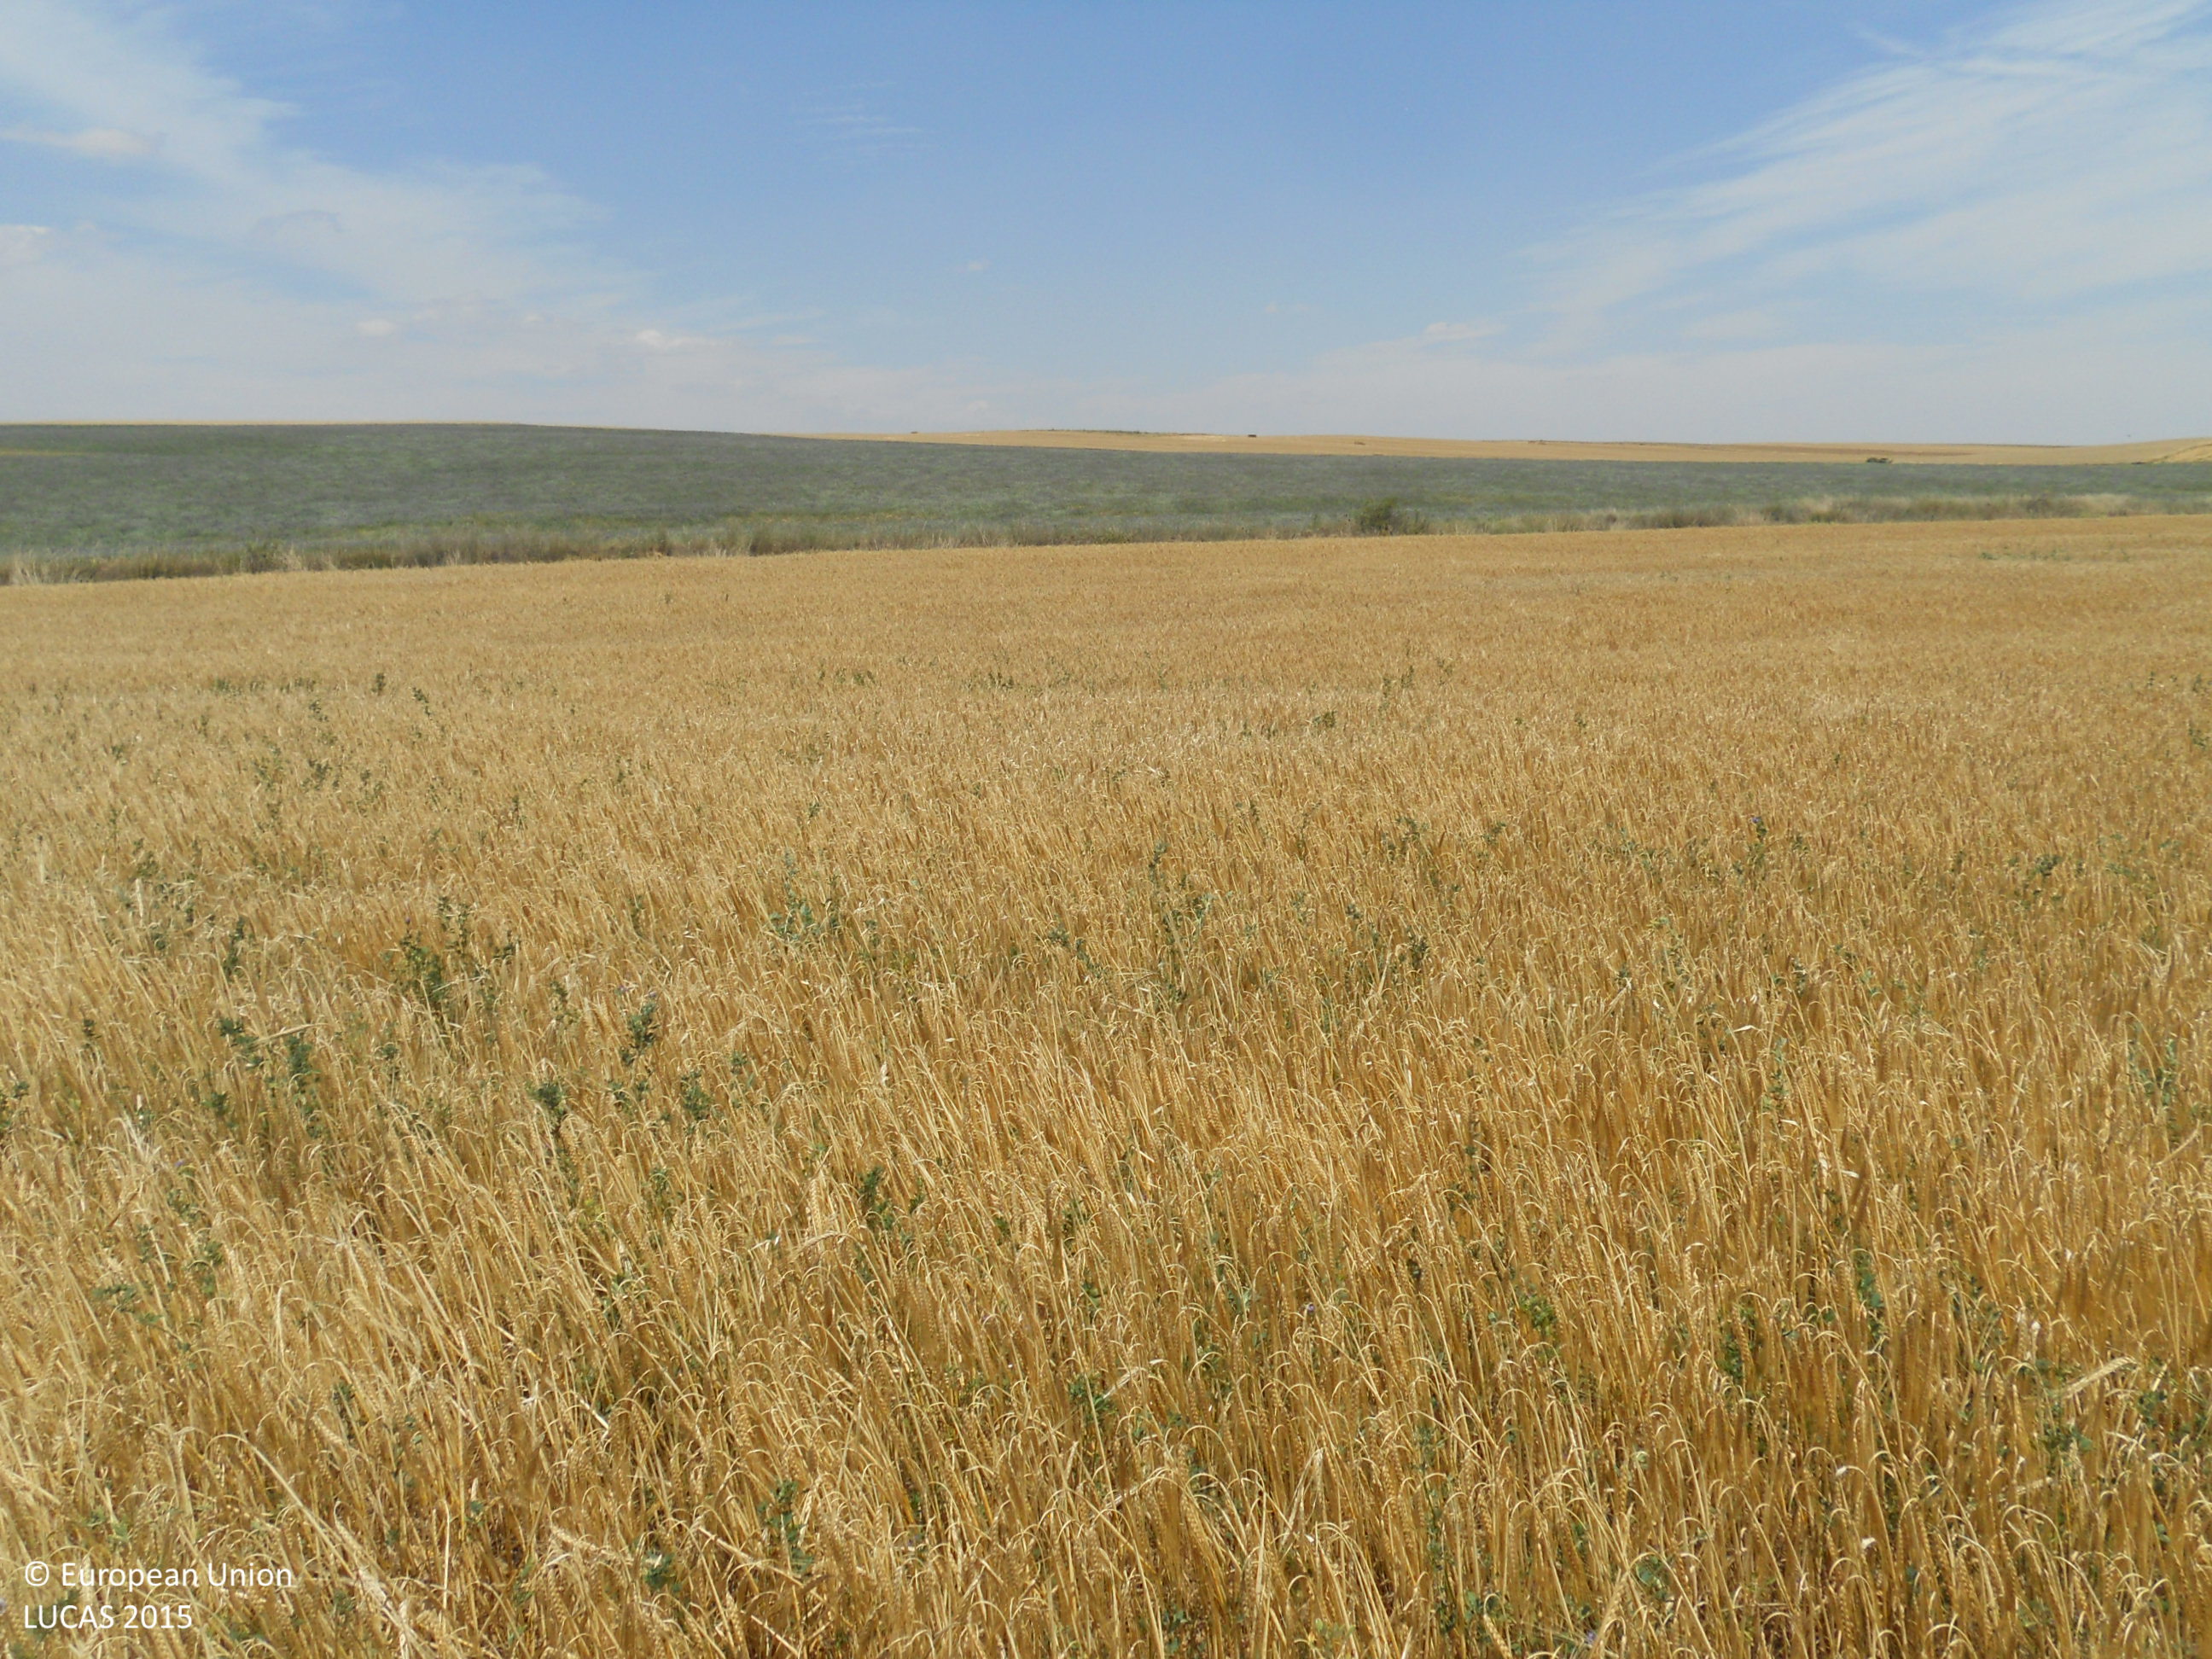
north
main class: Cropland
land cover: Barley
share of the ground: > 75 %
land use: Agriculture (excluding fallow land and kitchen gardens)
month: July
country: ES
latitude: 42.1955
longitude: -4.8399
